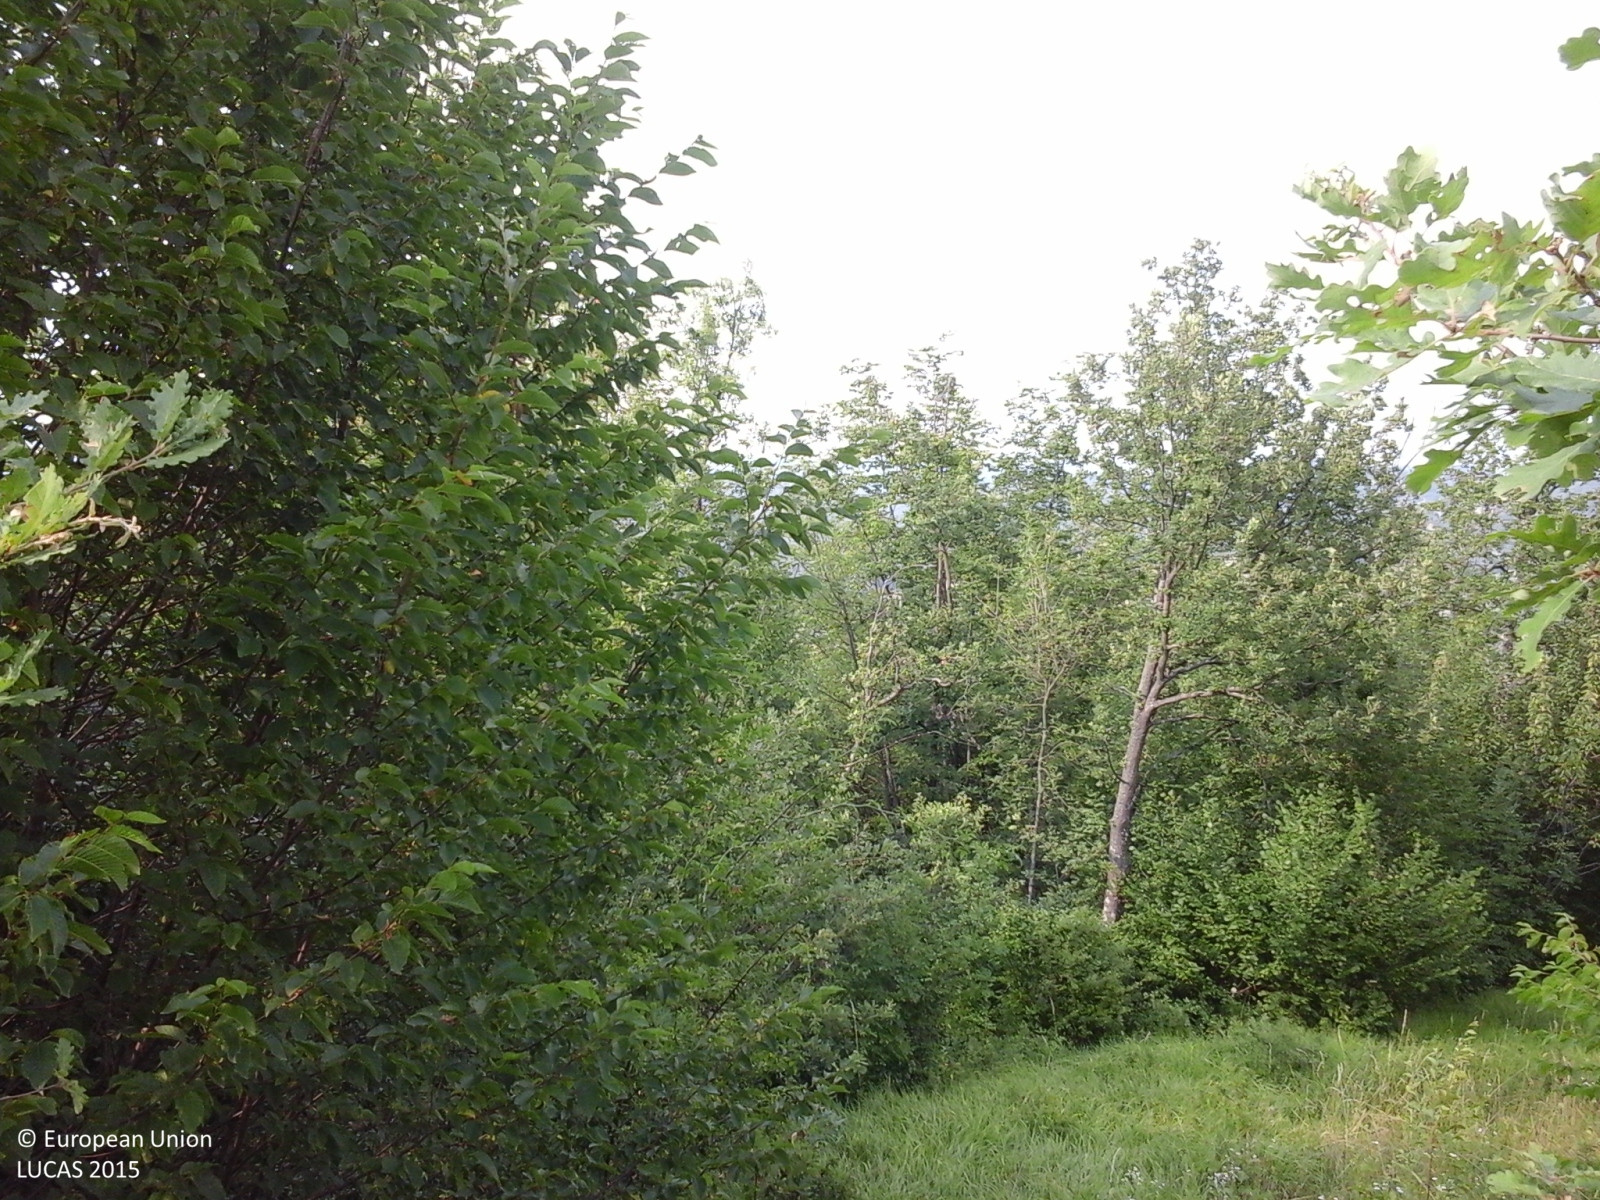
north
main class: Woodland
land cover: Broadleaved woodland
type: thermophilous deciduous forest
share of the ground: > 75 %
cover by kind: broadleaved forest trees 75 %, herbaceous plants 15 %, shrubs 10 %
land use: Agriculture (excluding fallow land and kitchen gardens)
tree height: < 5 m
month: July
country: IT
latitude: 44.7615
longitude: 9.1049
